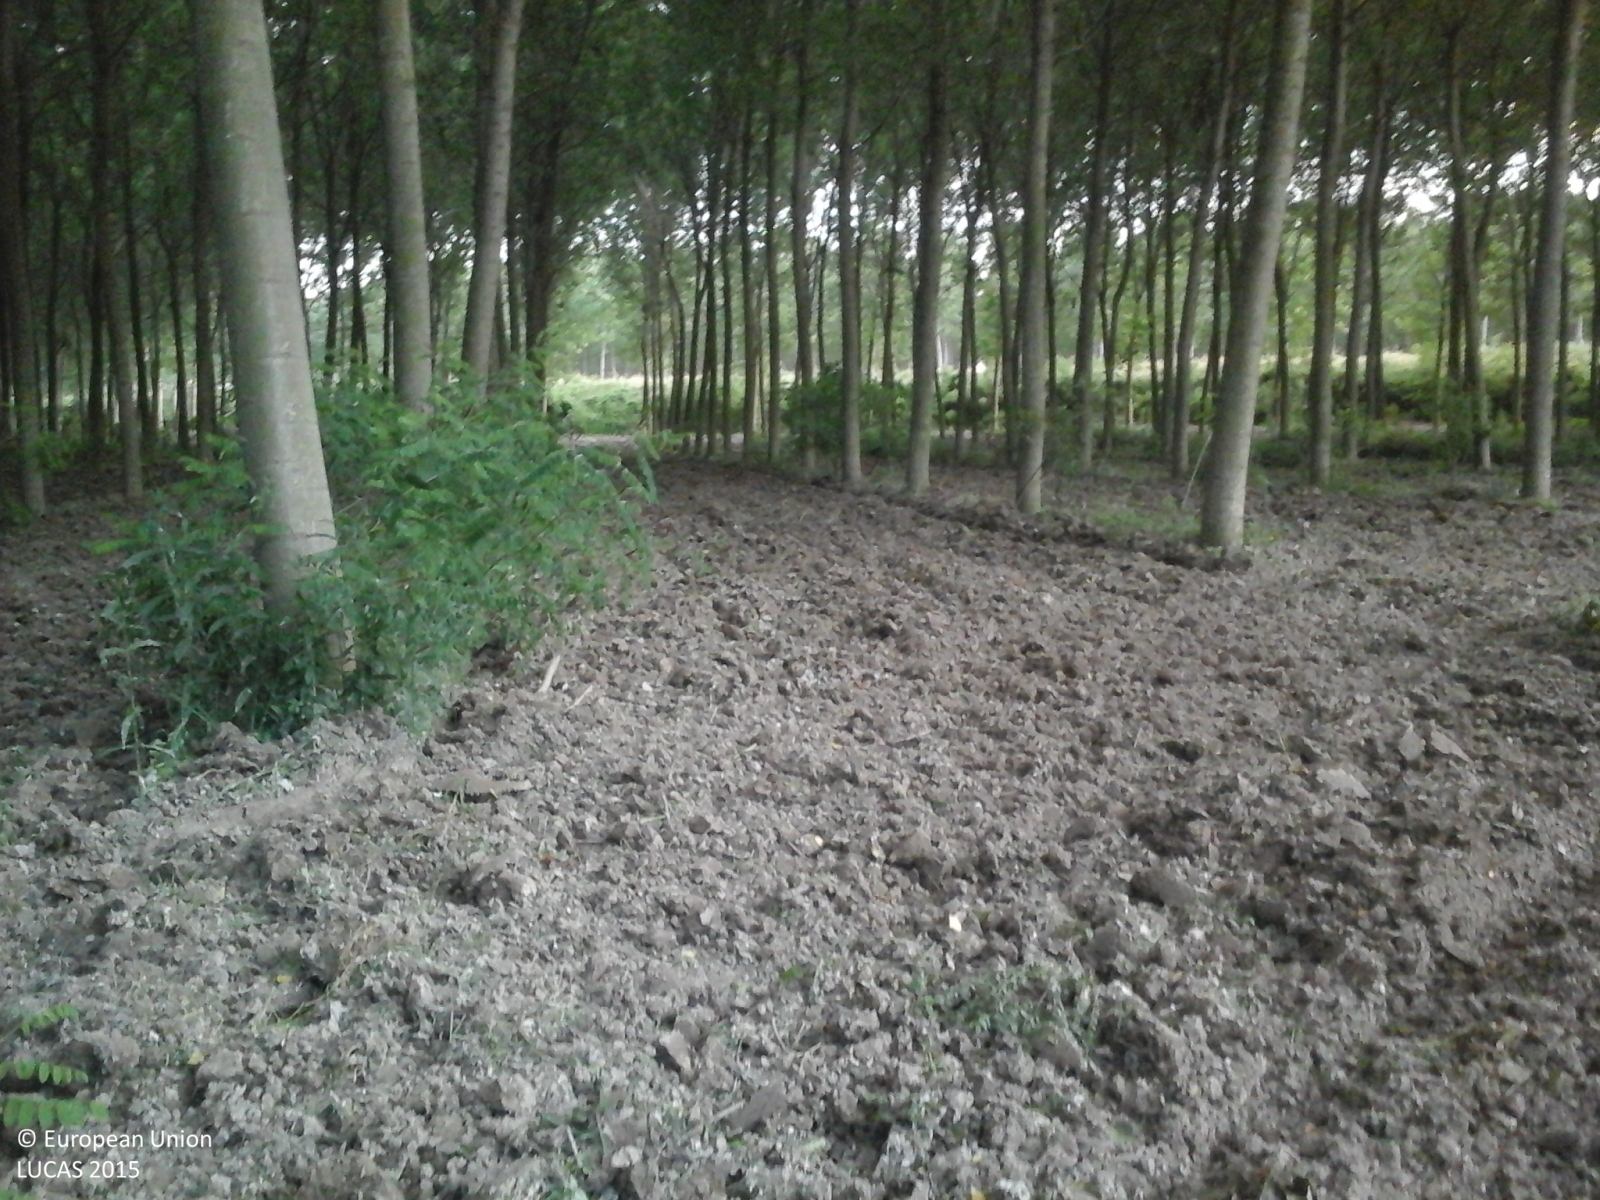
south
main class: Woodland
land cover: Broadleaved woodland
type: non-riverine alder, birch or aspen forest
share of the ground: > 75 %
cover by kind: broadleaved forest trees 100 %
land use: Forestry
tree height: > 5 m
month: May
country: IT
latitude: 45.0680
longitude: 10.9000
